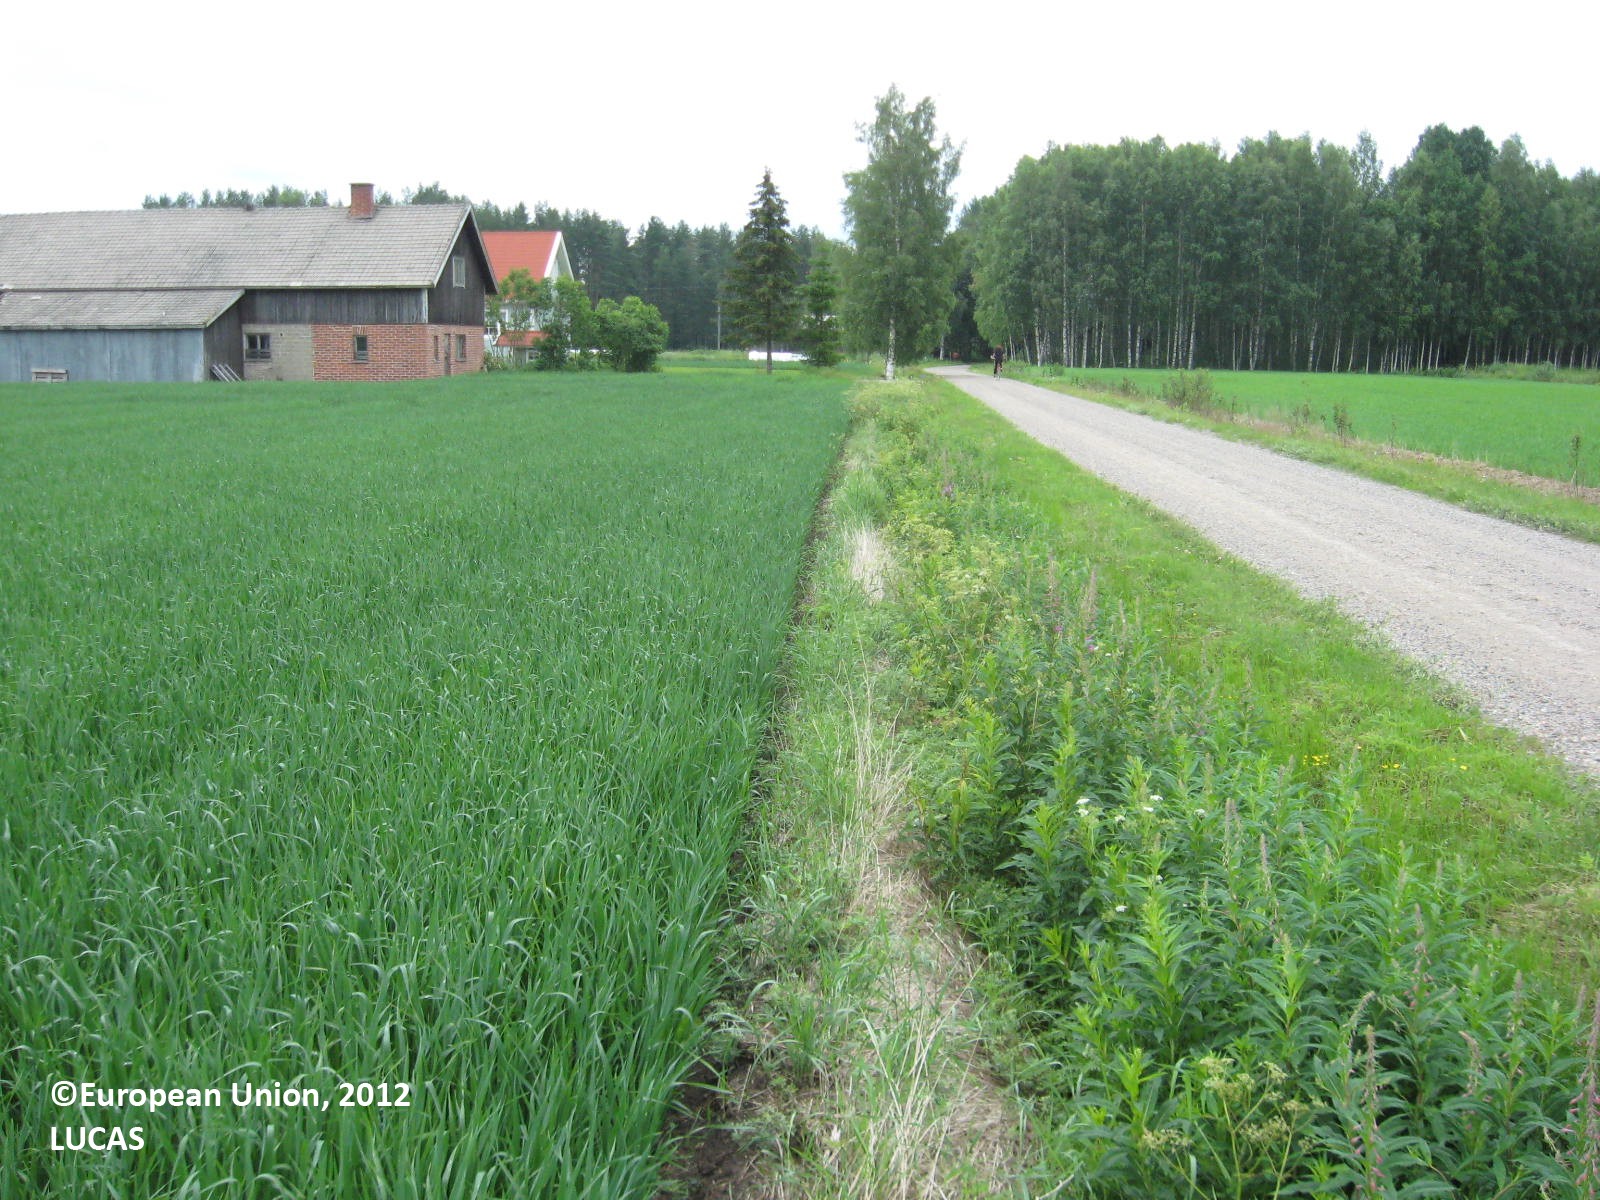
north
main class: Cropland
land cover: Oats
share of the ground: > 75 %
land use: Agriculture (excluding fallow land and kitchen gardens)
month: July
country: FI
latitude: 62.3972
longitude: 22.5352
